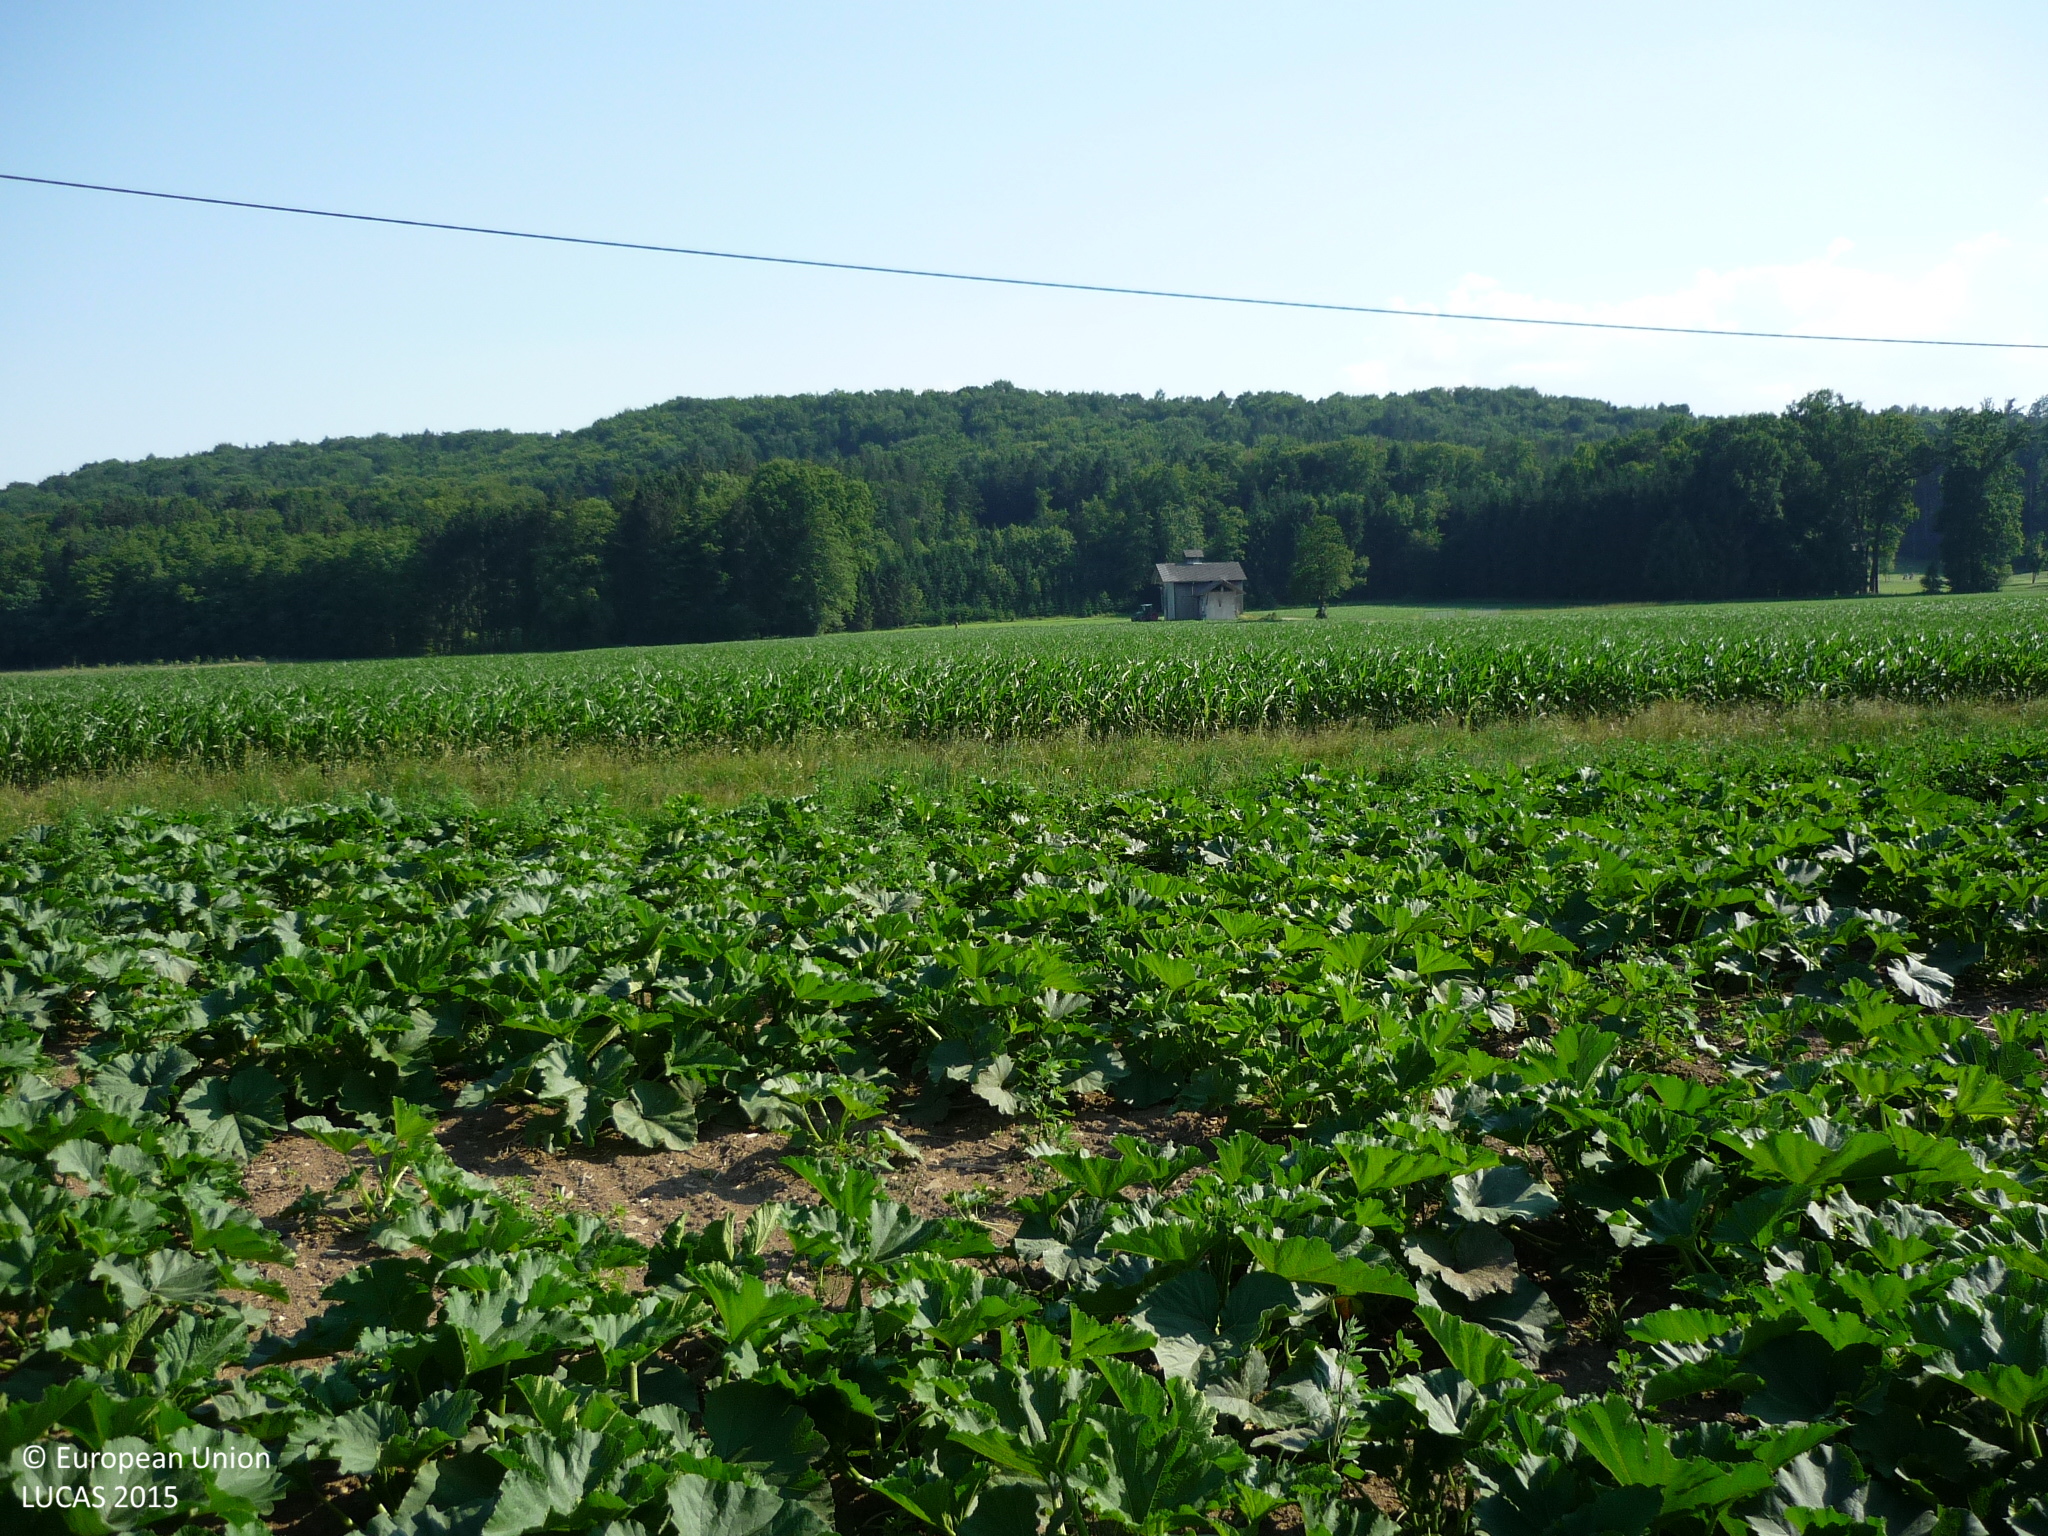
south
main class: Cropland
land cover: Other fresh vegetables
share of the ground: > 75 %
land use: Agriculture (excluding fallow land and kitchen gardens)
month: June
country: AT
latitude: 46.8176
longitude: 15.2547
